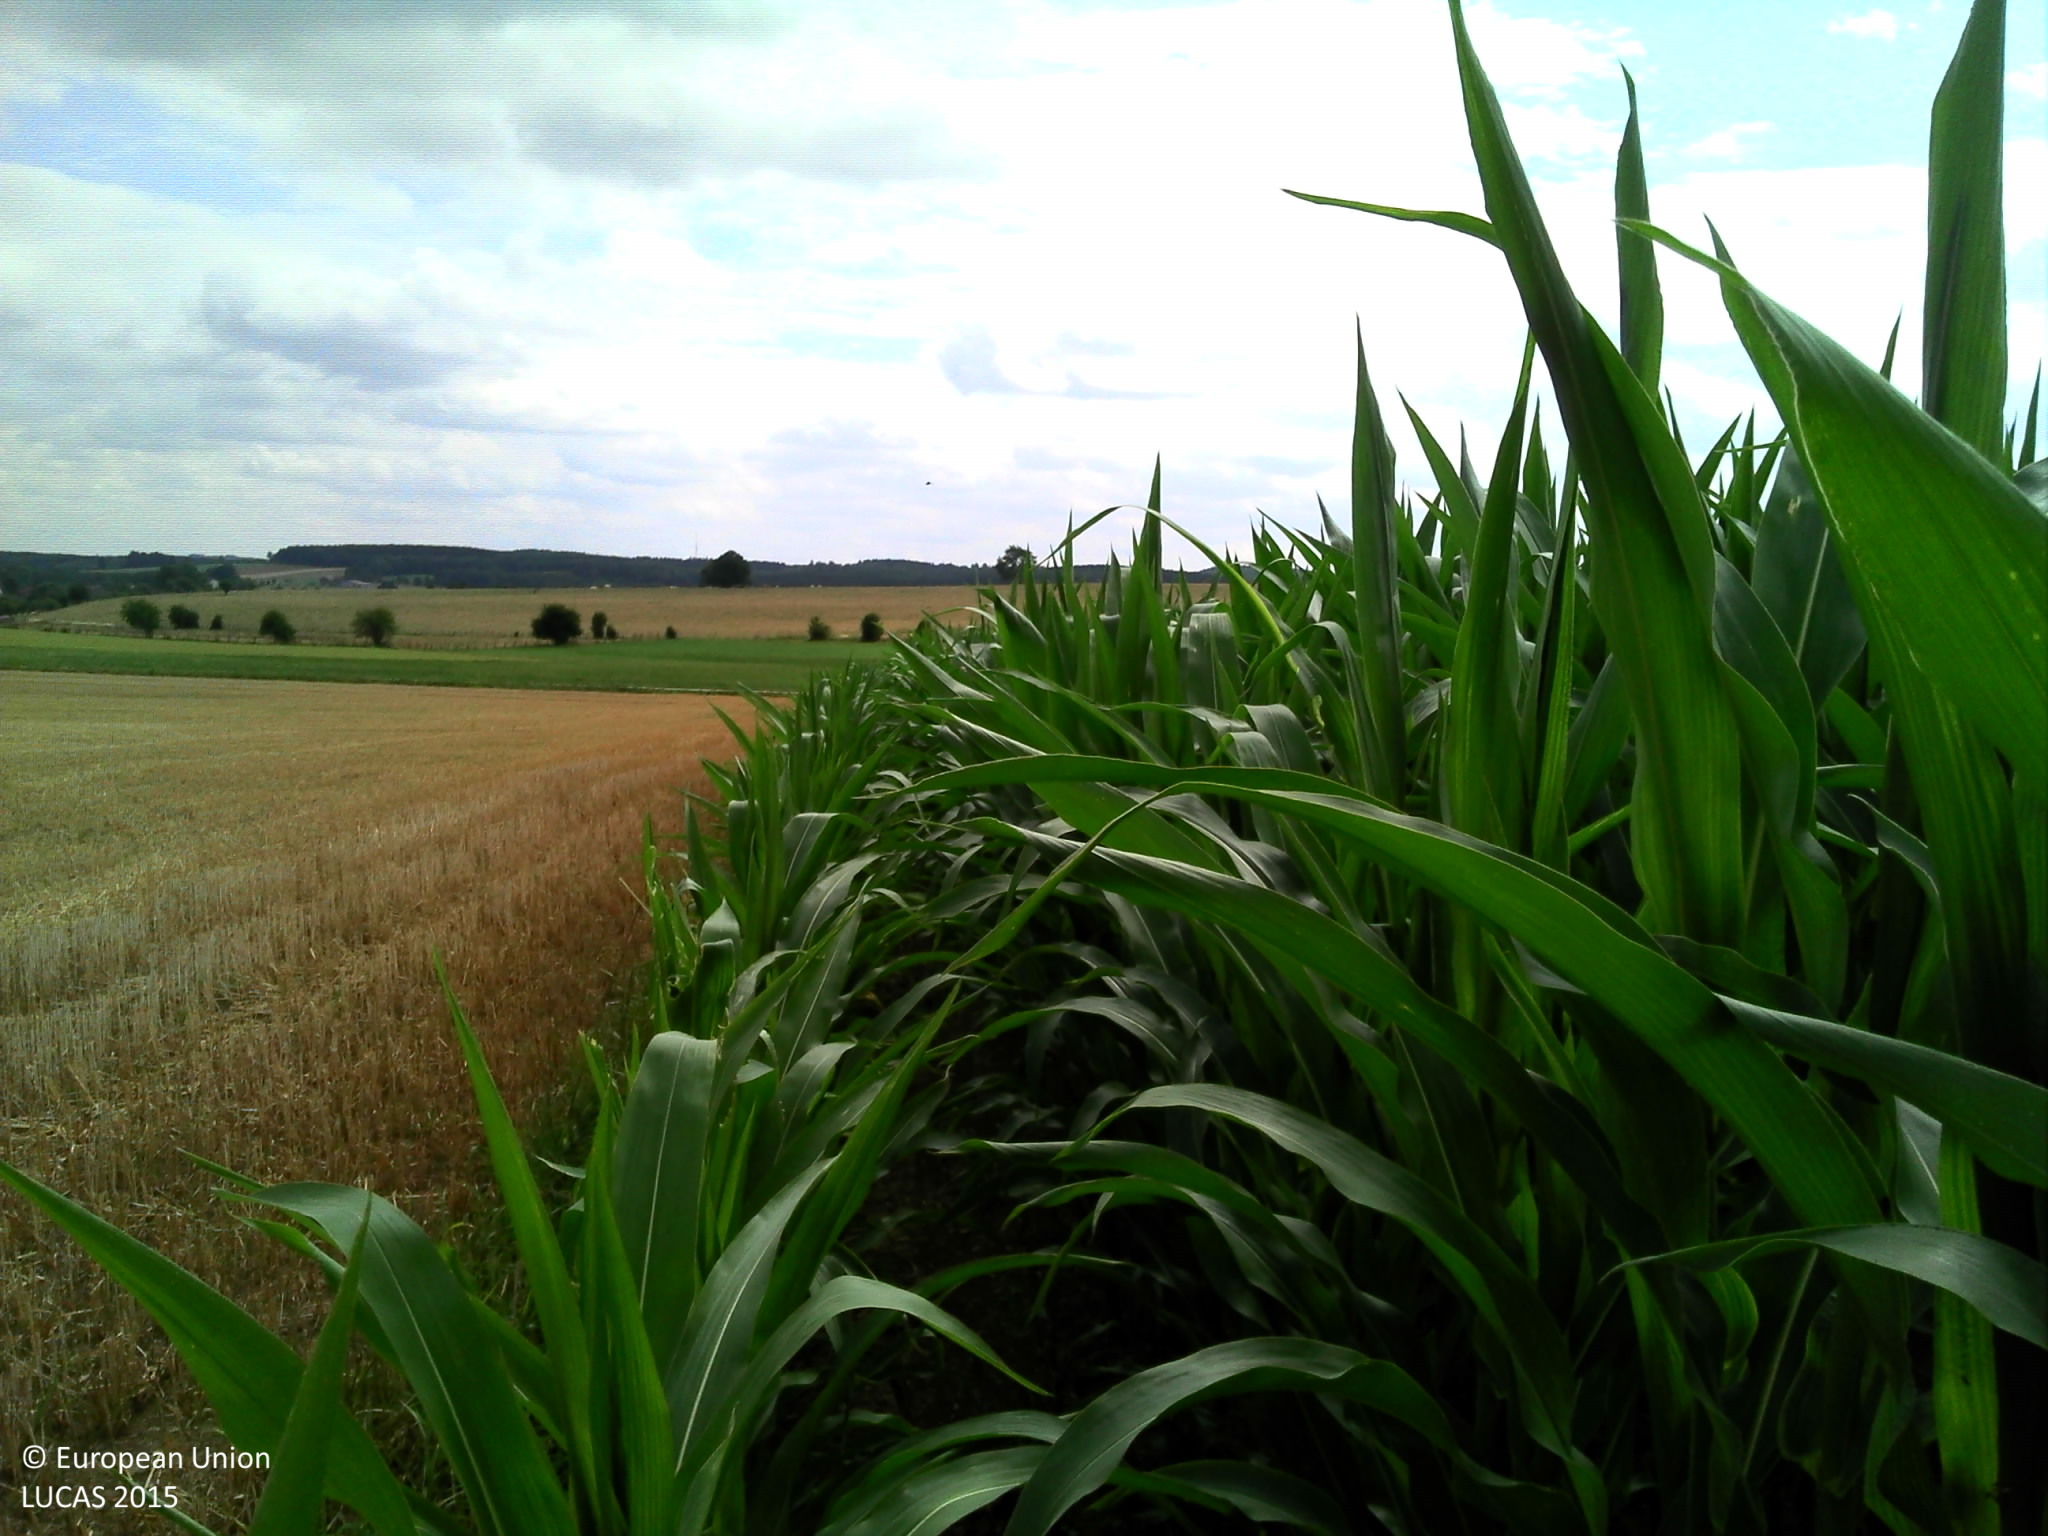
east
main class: Cropland
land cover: Maize
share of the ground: > 75 %
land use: Agriculture (excluding fallow land and kitchen gardens)
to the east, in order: Maize; Grass margins; Paved roads, cycling and walking lanes; Grassland without tree/shrub cover
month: July
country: BE
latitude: 49.7908
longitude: 5.5395
